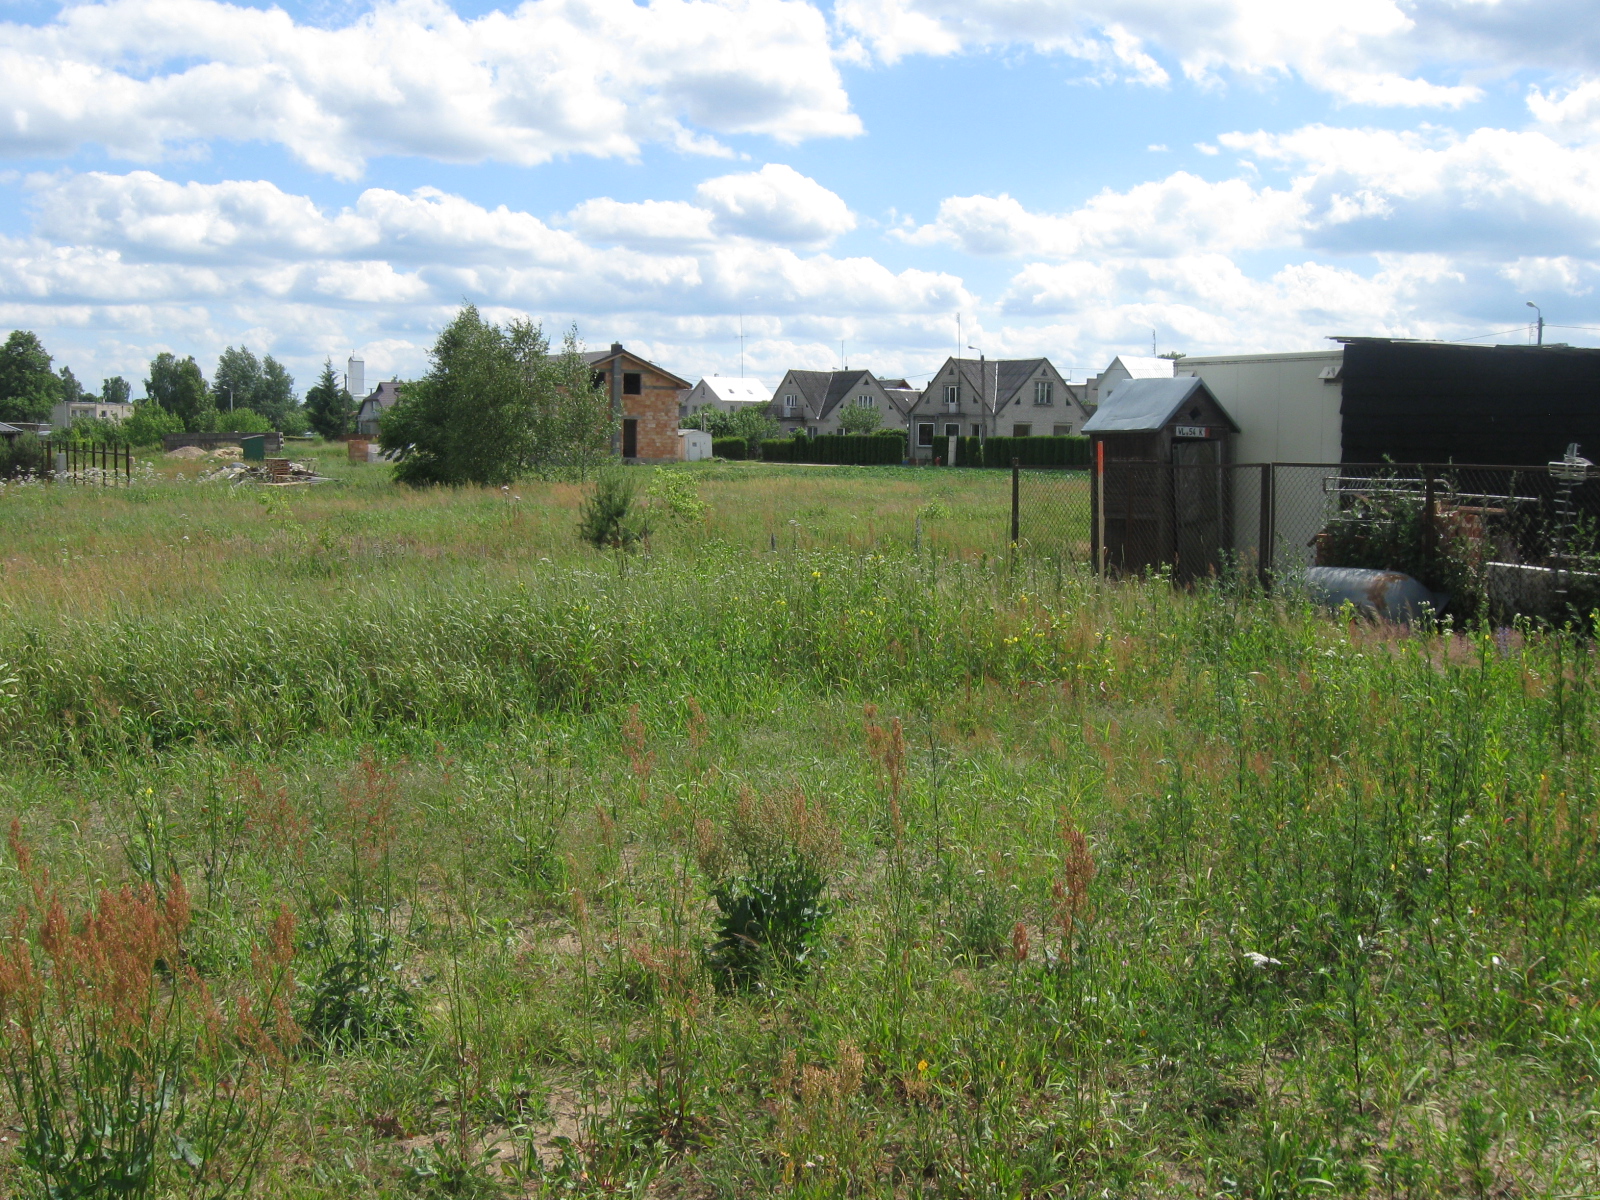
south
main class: Grassland
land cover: Spontaneously vegetated surfaces
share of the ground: > 75 %
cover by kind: herbaceous plants 75 %, unconsolidated bare surface 25 %
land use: Fallow land
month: June
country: LT
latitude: 54.2543
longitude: 24.5484
